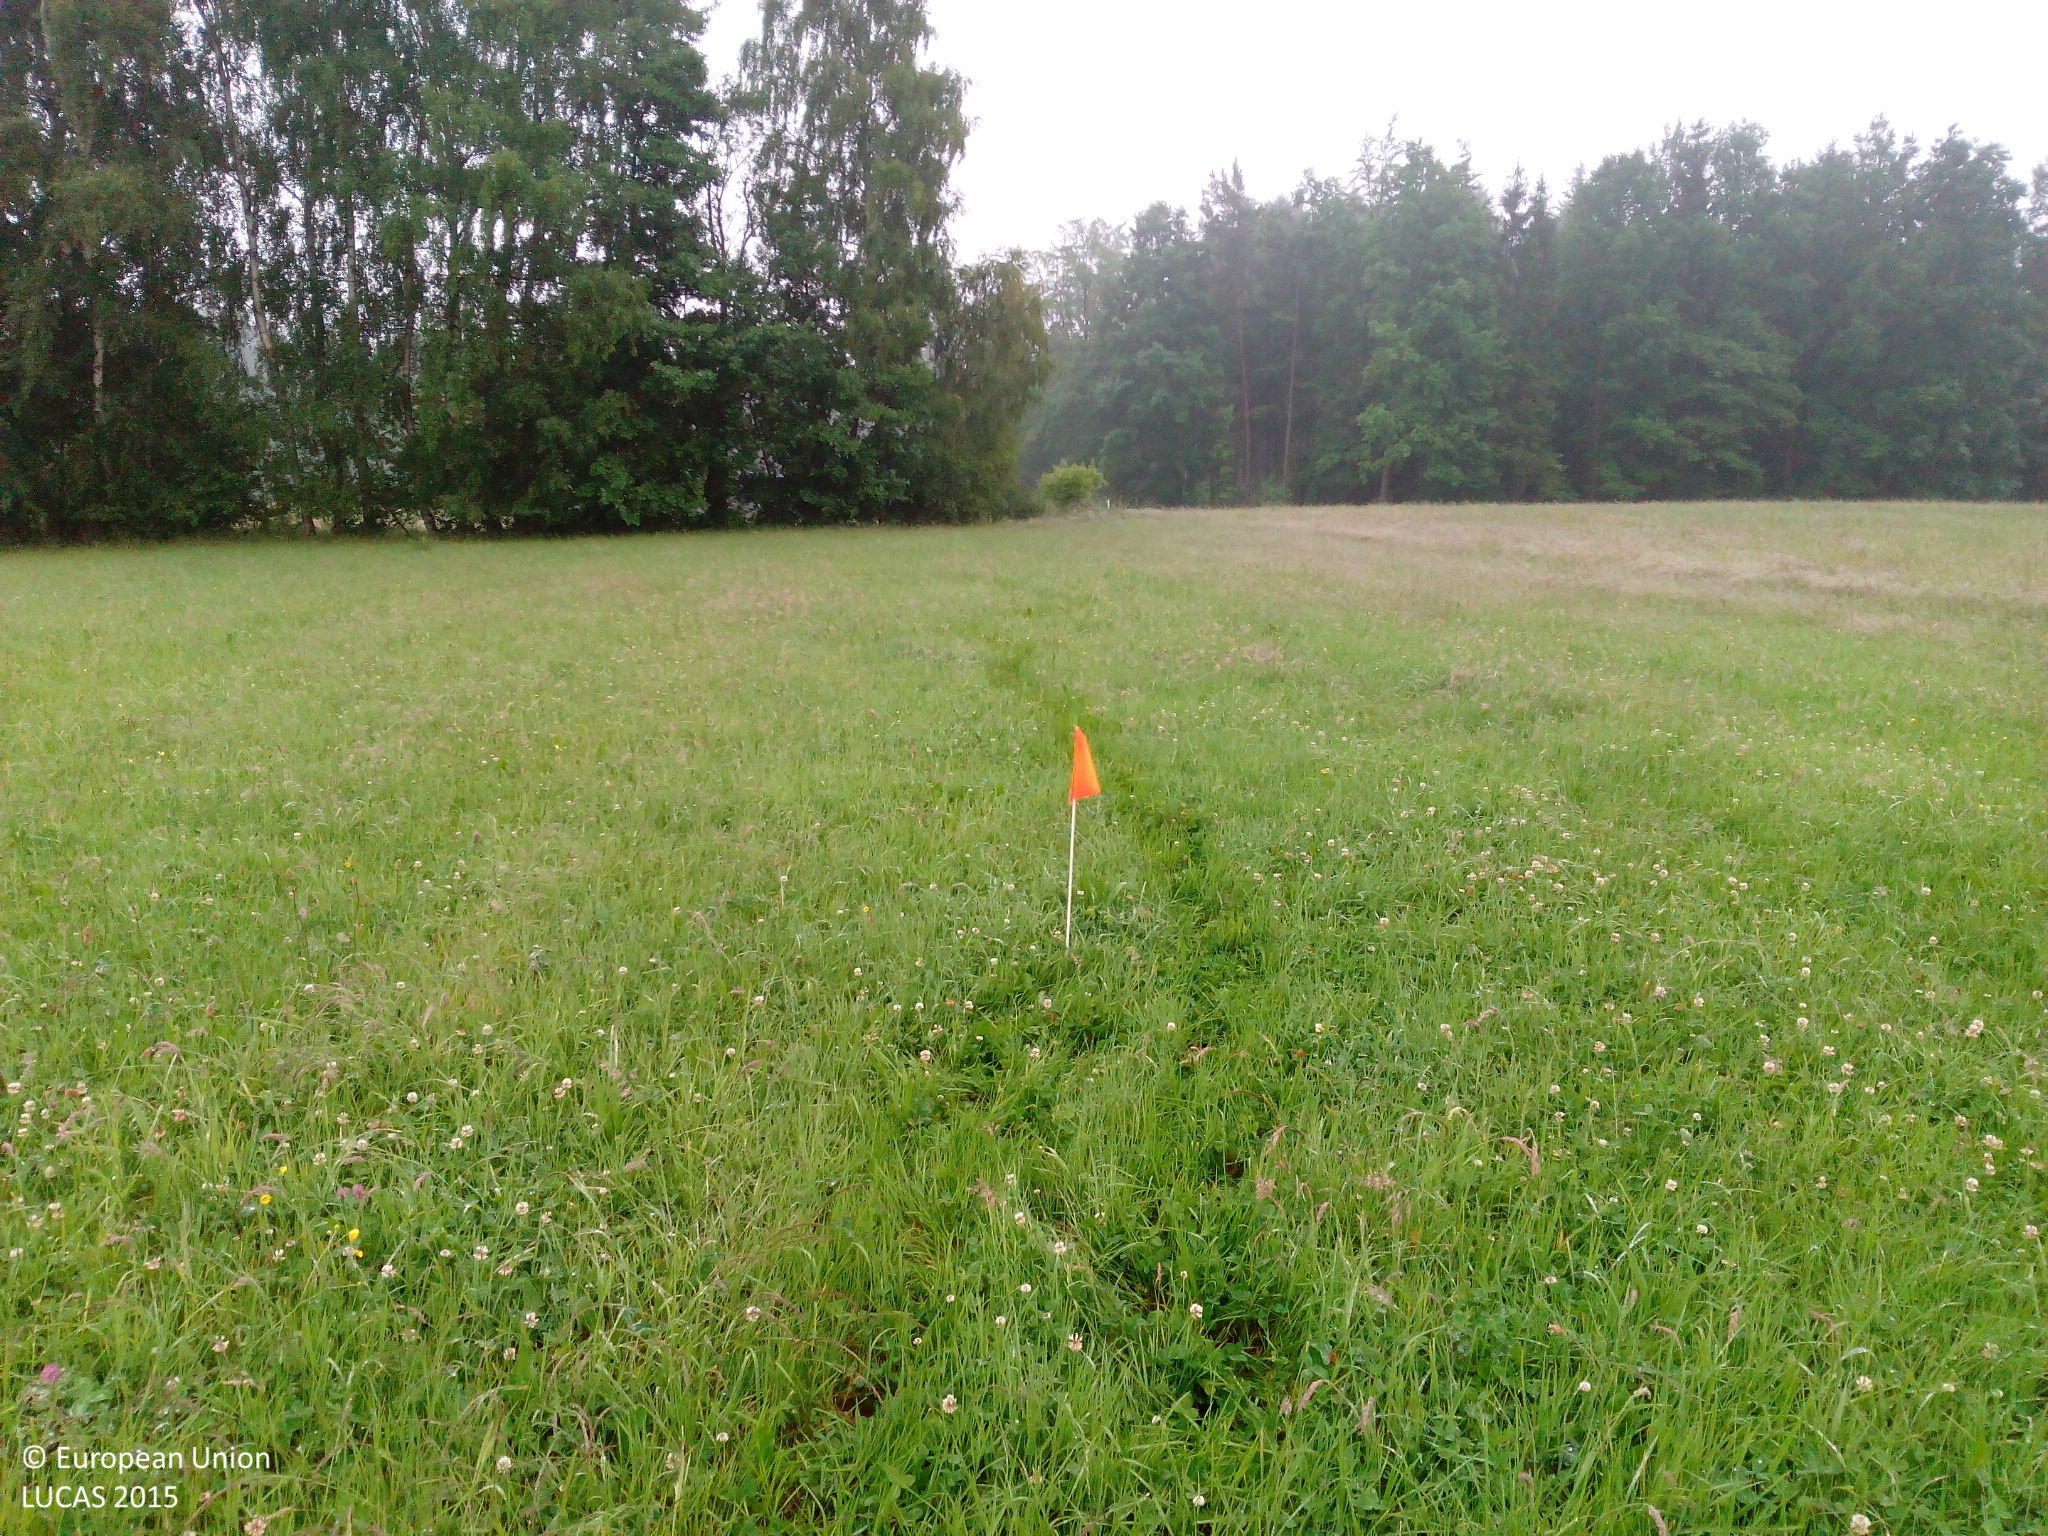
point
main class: Grassland
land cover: Grassland without tree/shrub cover
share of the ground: > 75 %
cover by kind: herbaceous plants 100 %
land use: Agriculture (excluding fallow land and kitchen gardens)
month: June
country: DE
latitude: 50.0845
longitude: 11.4950
